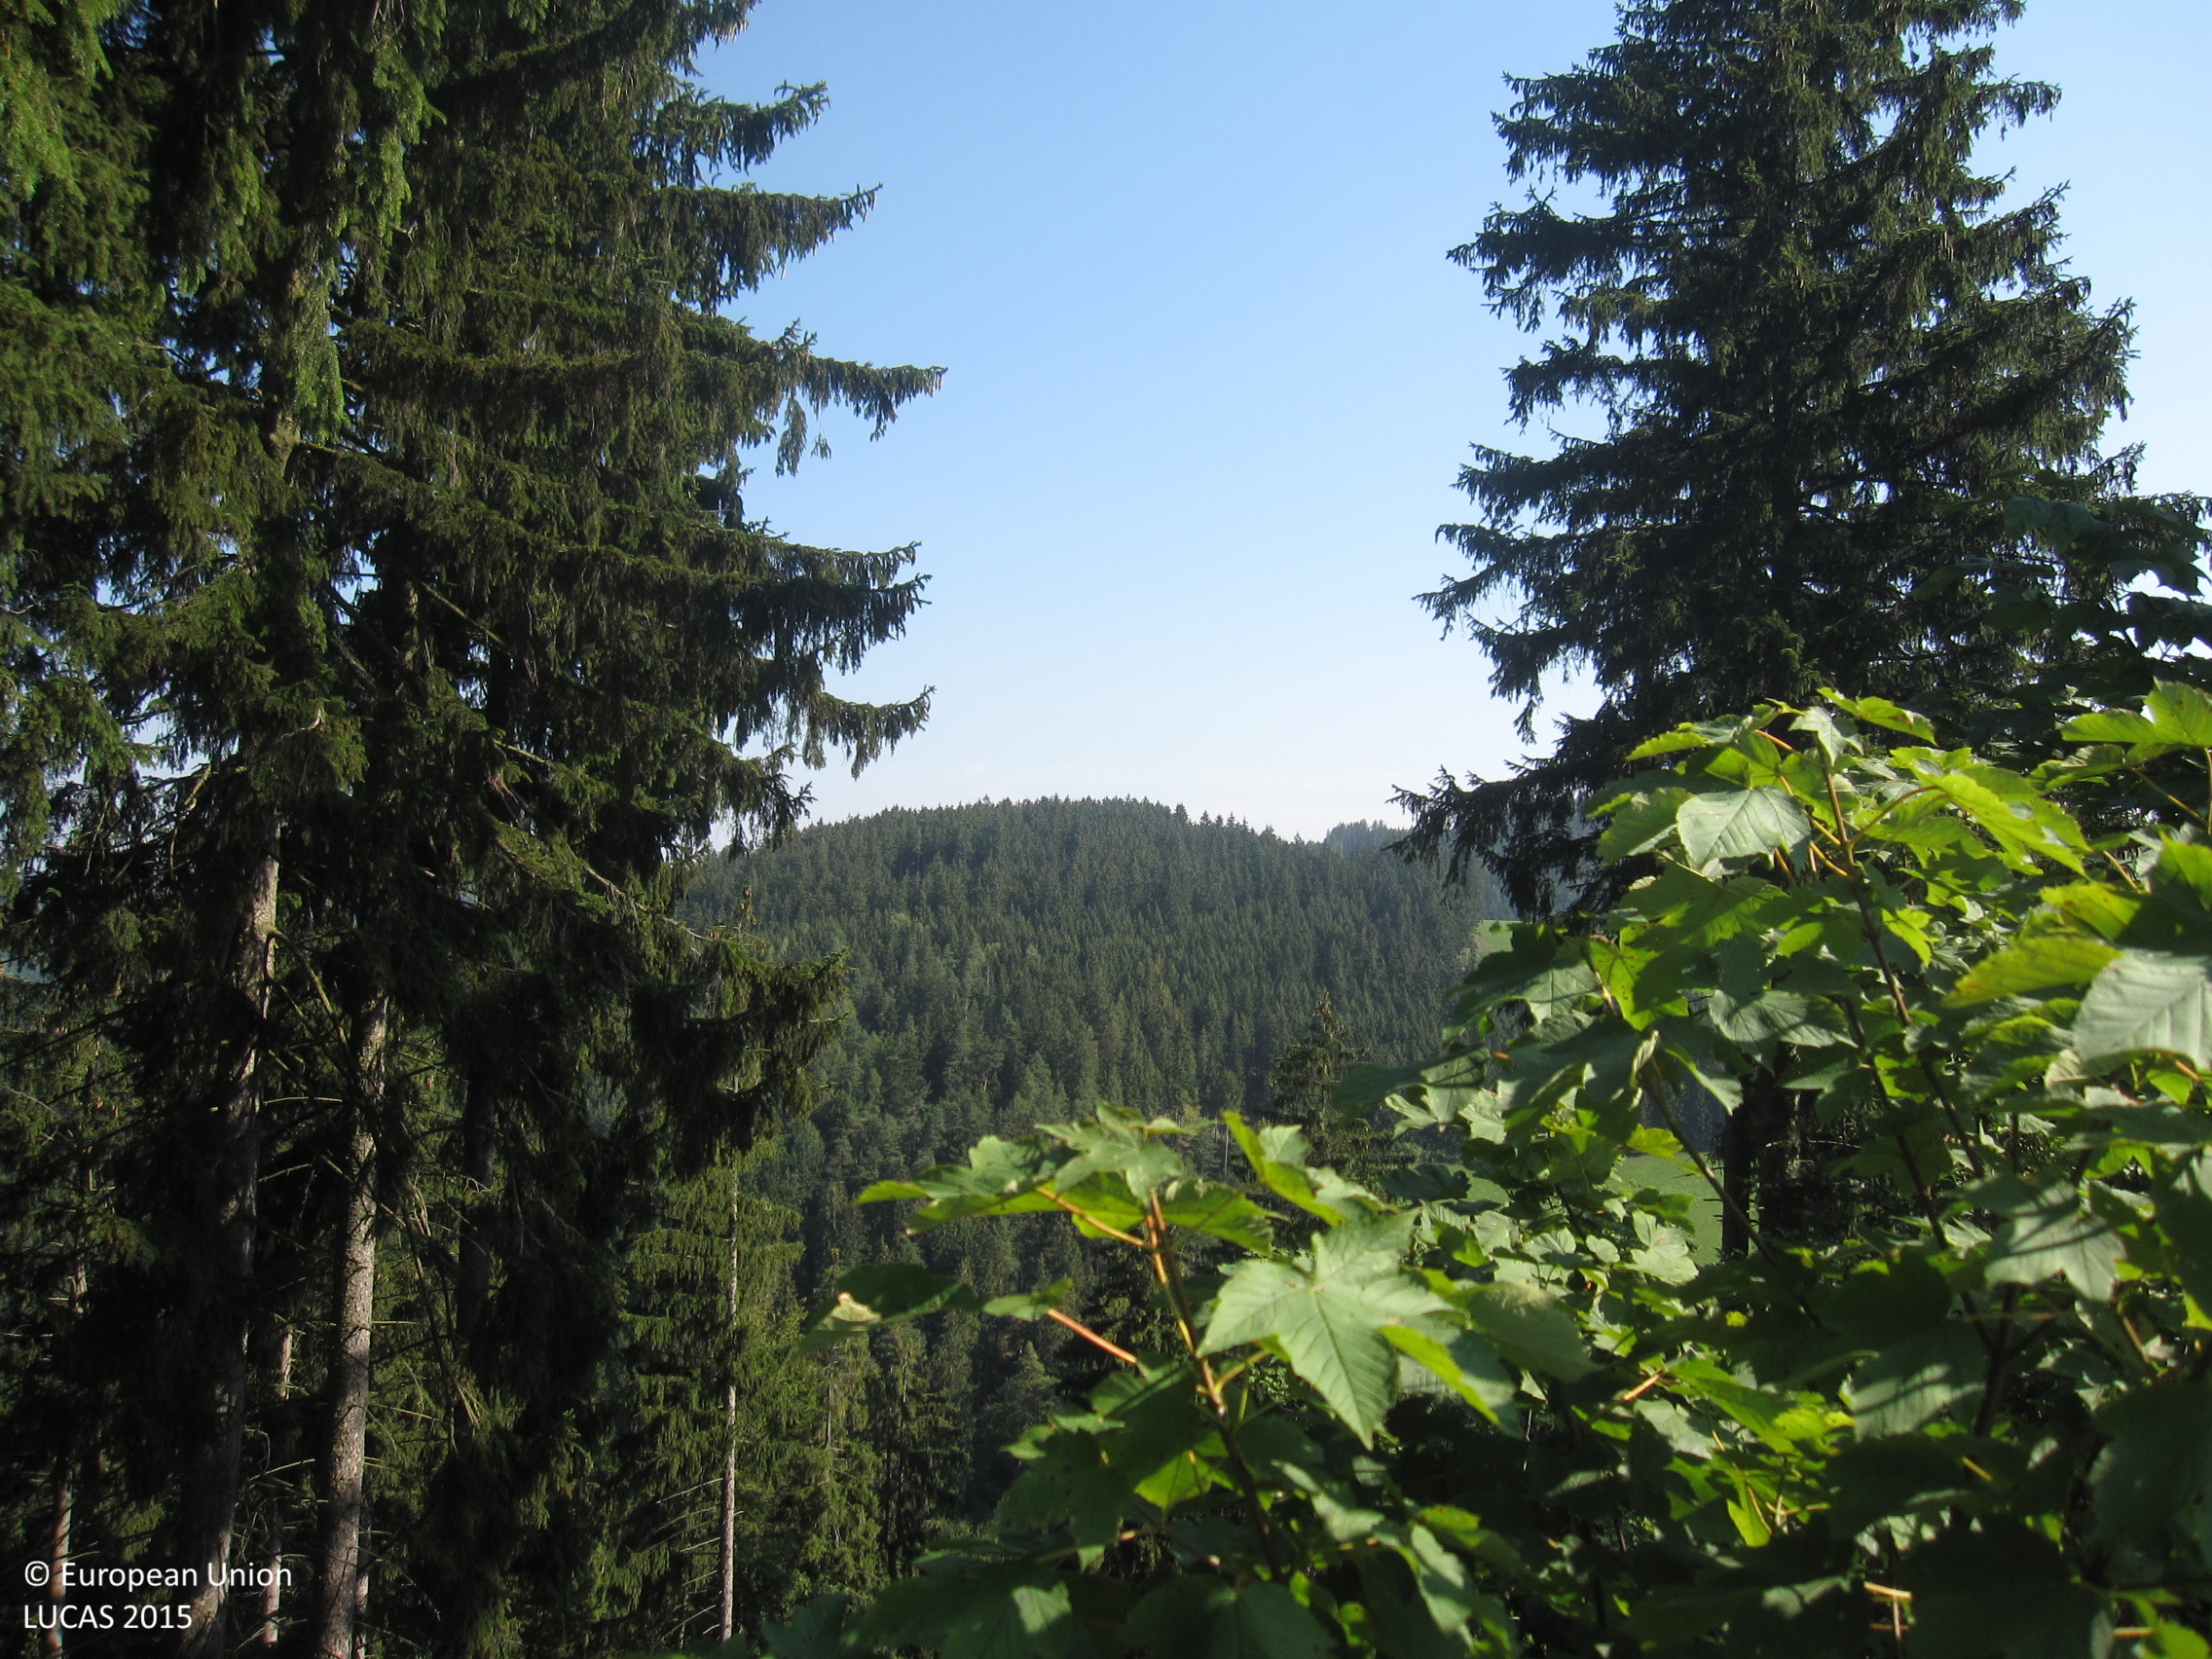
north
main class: Woodland
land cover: Spruce dominated mixed woodland
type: hemiboreal forest and nemoral coniferous forest and mixed broadleaved-coniferous forest
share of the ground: > 75 %
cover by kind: coniferous forest trees 50 %, broadleaved forest trees 35 %, shrubs 15 %
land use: Forestry
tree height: > 5 m
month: August
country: DE
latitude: 50.4994
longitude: 11.3954
